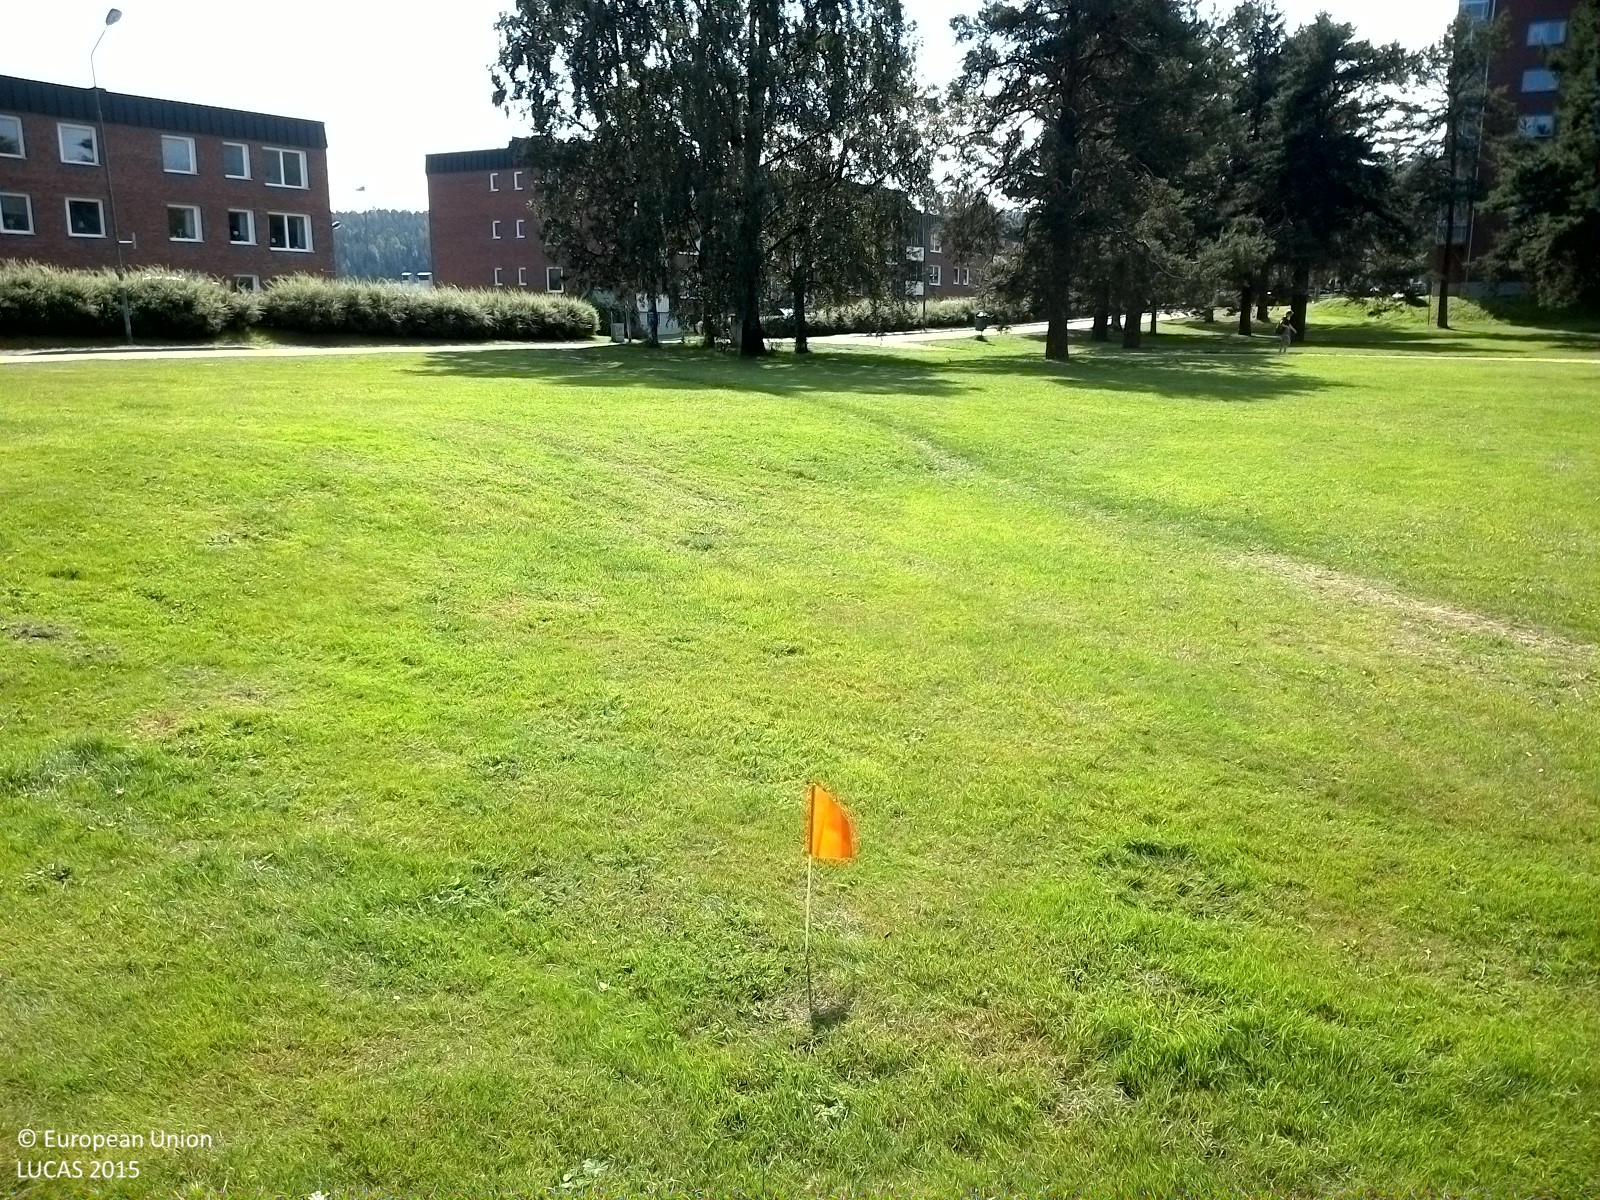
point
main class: Grassland
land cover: Grassland without tree/shrub cover
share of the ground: > 75 %
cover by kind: herbaceous plants 100 %
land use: Amenities, museums, leisure
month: August
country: SE
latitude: 62.3786
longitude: 17.3469
